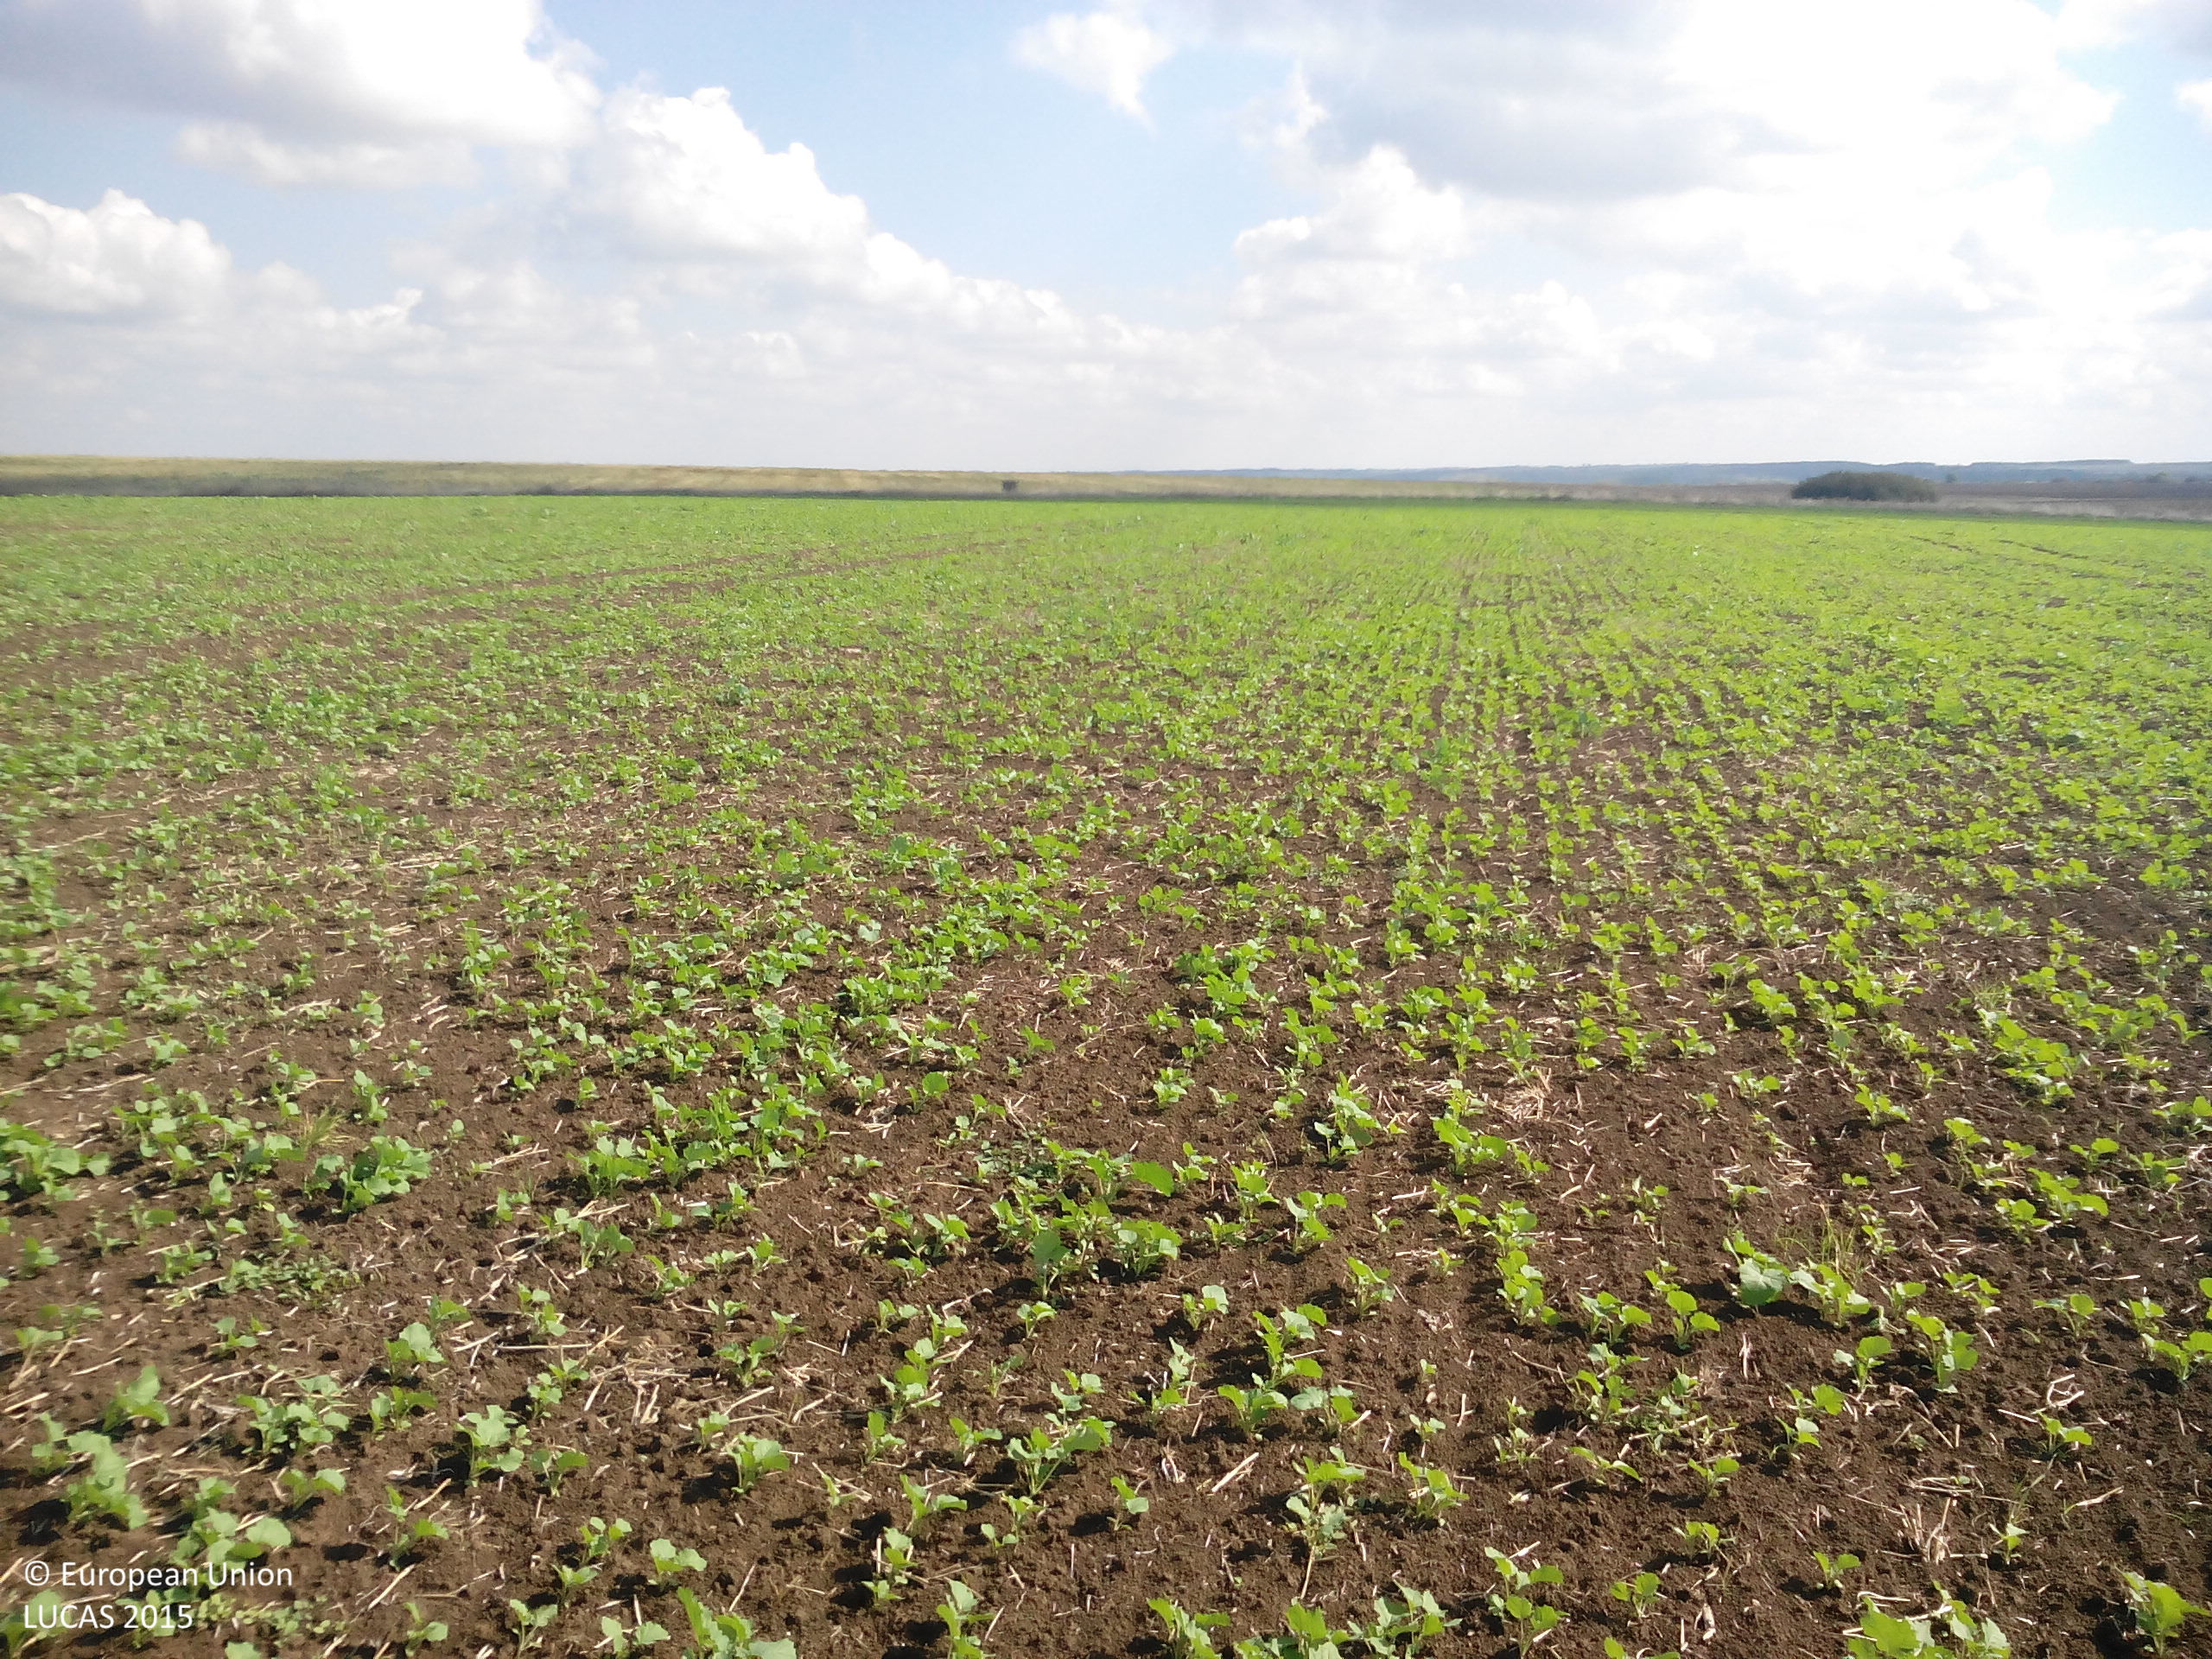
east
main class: Cropland
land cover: Rape and turnip rape
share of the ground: 25 - 50 %
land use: Agriculture (excluding fallow land and kitchen gardens)
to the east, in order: Rape and turnip rape; Grass margins; Tracks; Grass margins; Common wheat
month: October
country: BG
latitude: 43.3996
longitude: 23.8408
